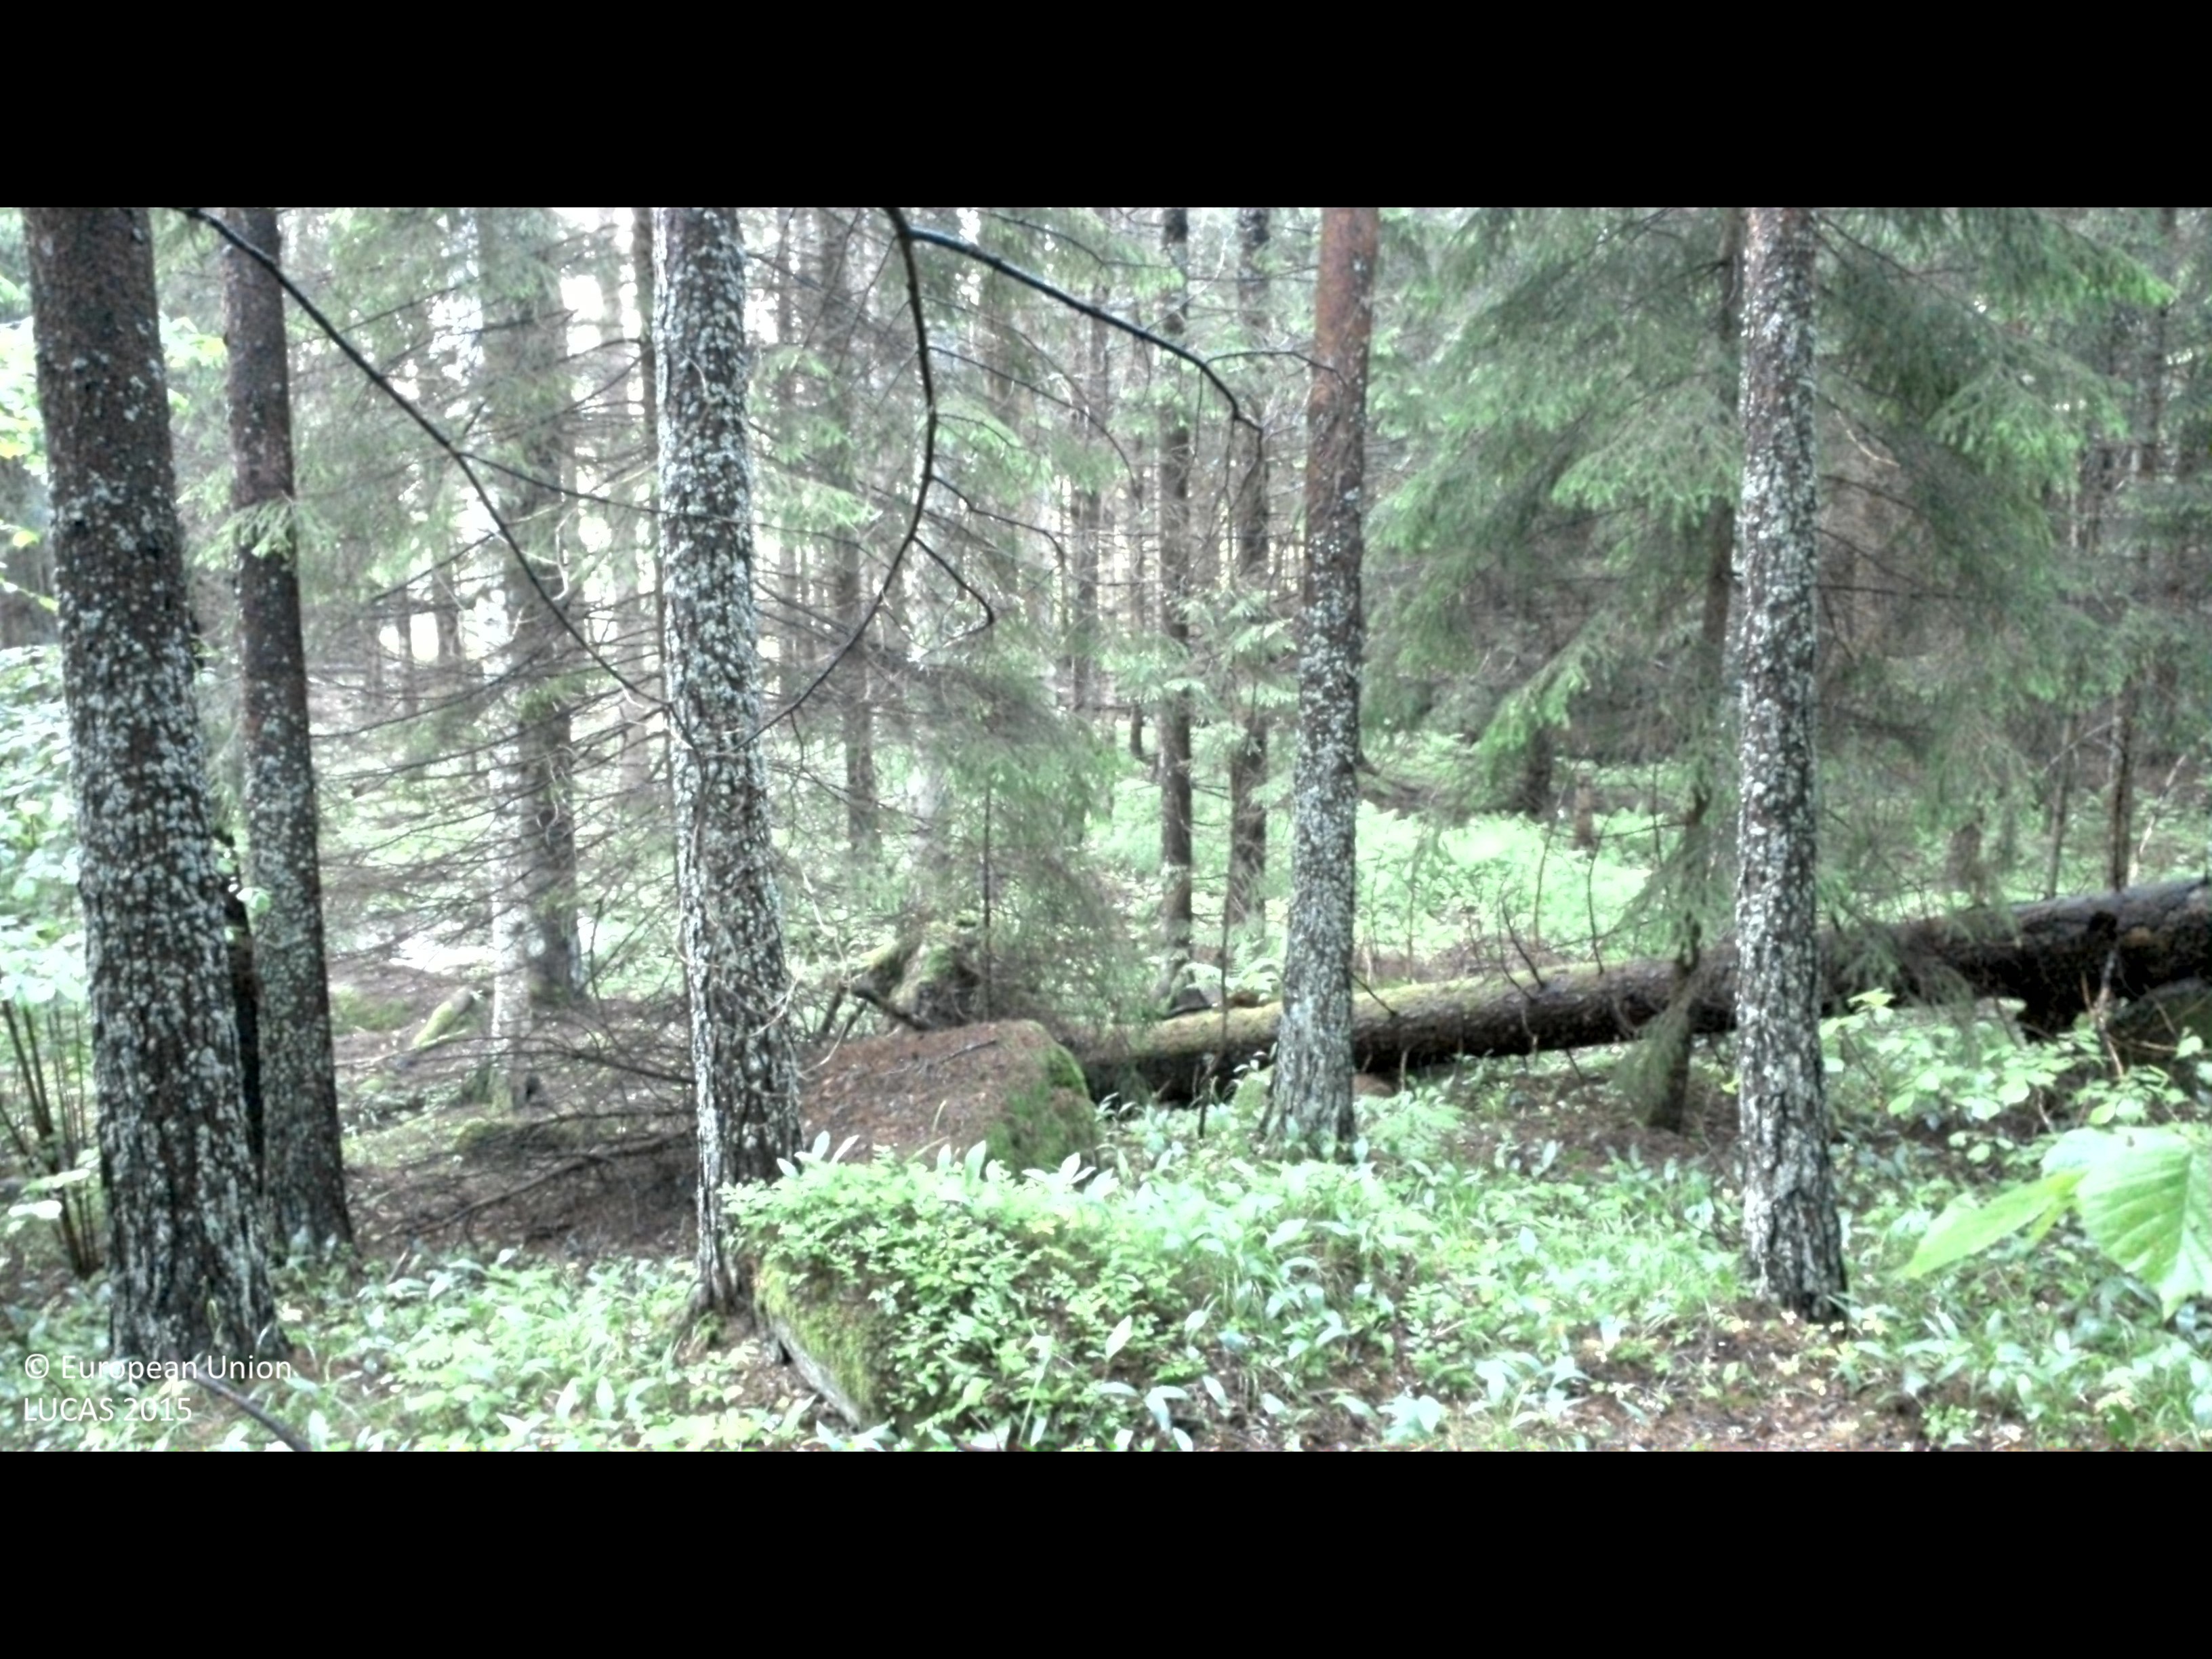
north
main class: Woodland
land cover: Spruce dominated coniferous woodland
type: boreal forest
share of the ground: > 75 %
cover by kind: coniferous forest trees 70 %, broadleaved forest trees 20 %, shrubs 5 %, herbaceous plants 5 %
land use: Forestry
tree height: > 5 m
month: June
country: SE
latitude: 58.0787
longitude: 16.1518
